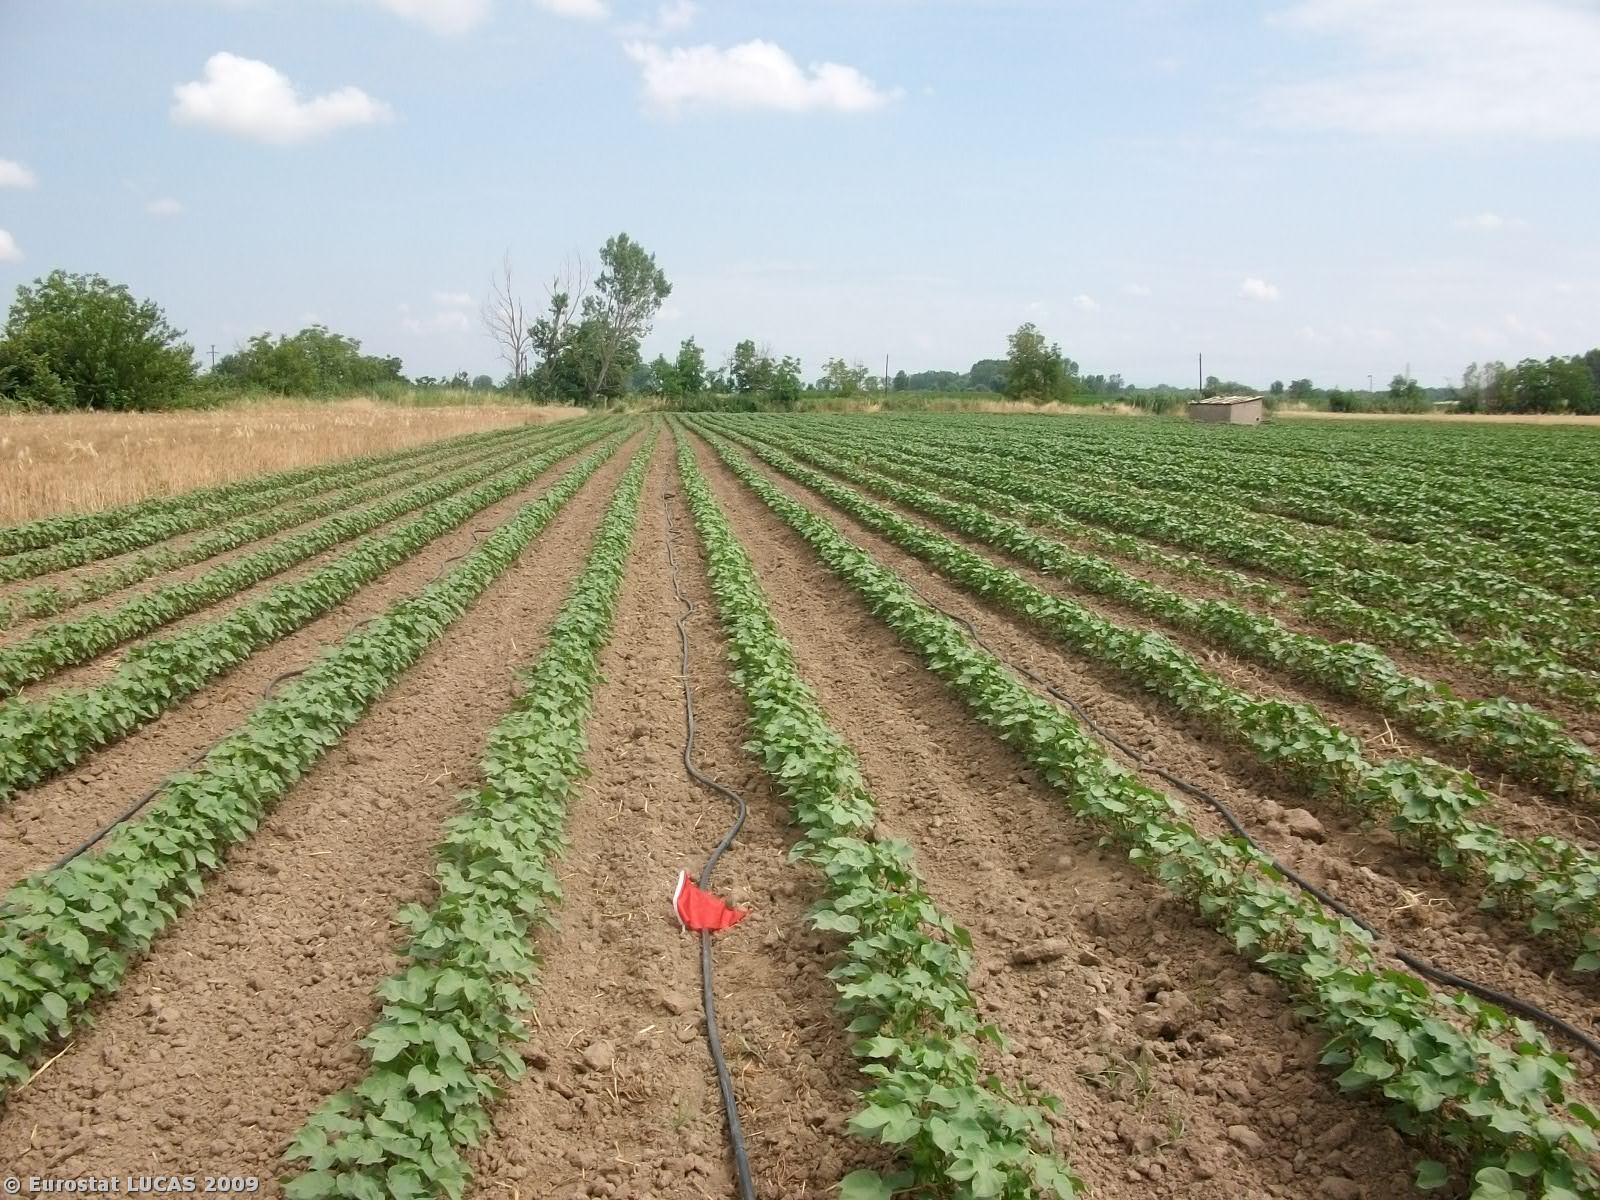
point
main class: Cropland
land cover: Cotton
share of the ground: 50 - 75 %
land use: Agriculture (excluding fallow land and kitchen gardens)
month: June
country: GR
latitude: 39.2803
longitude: 21.9333
